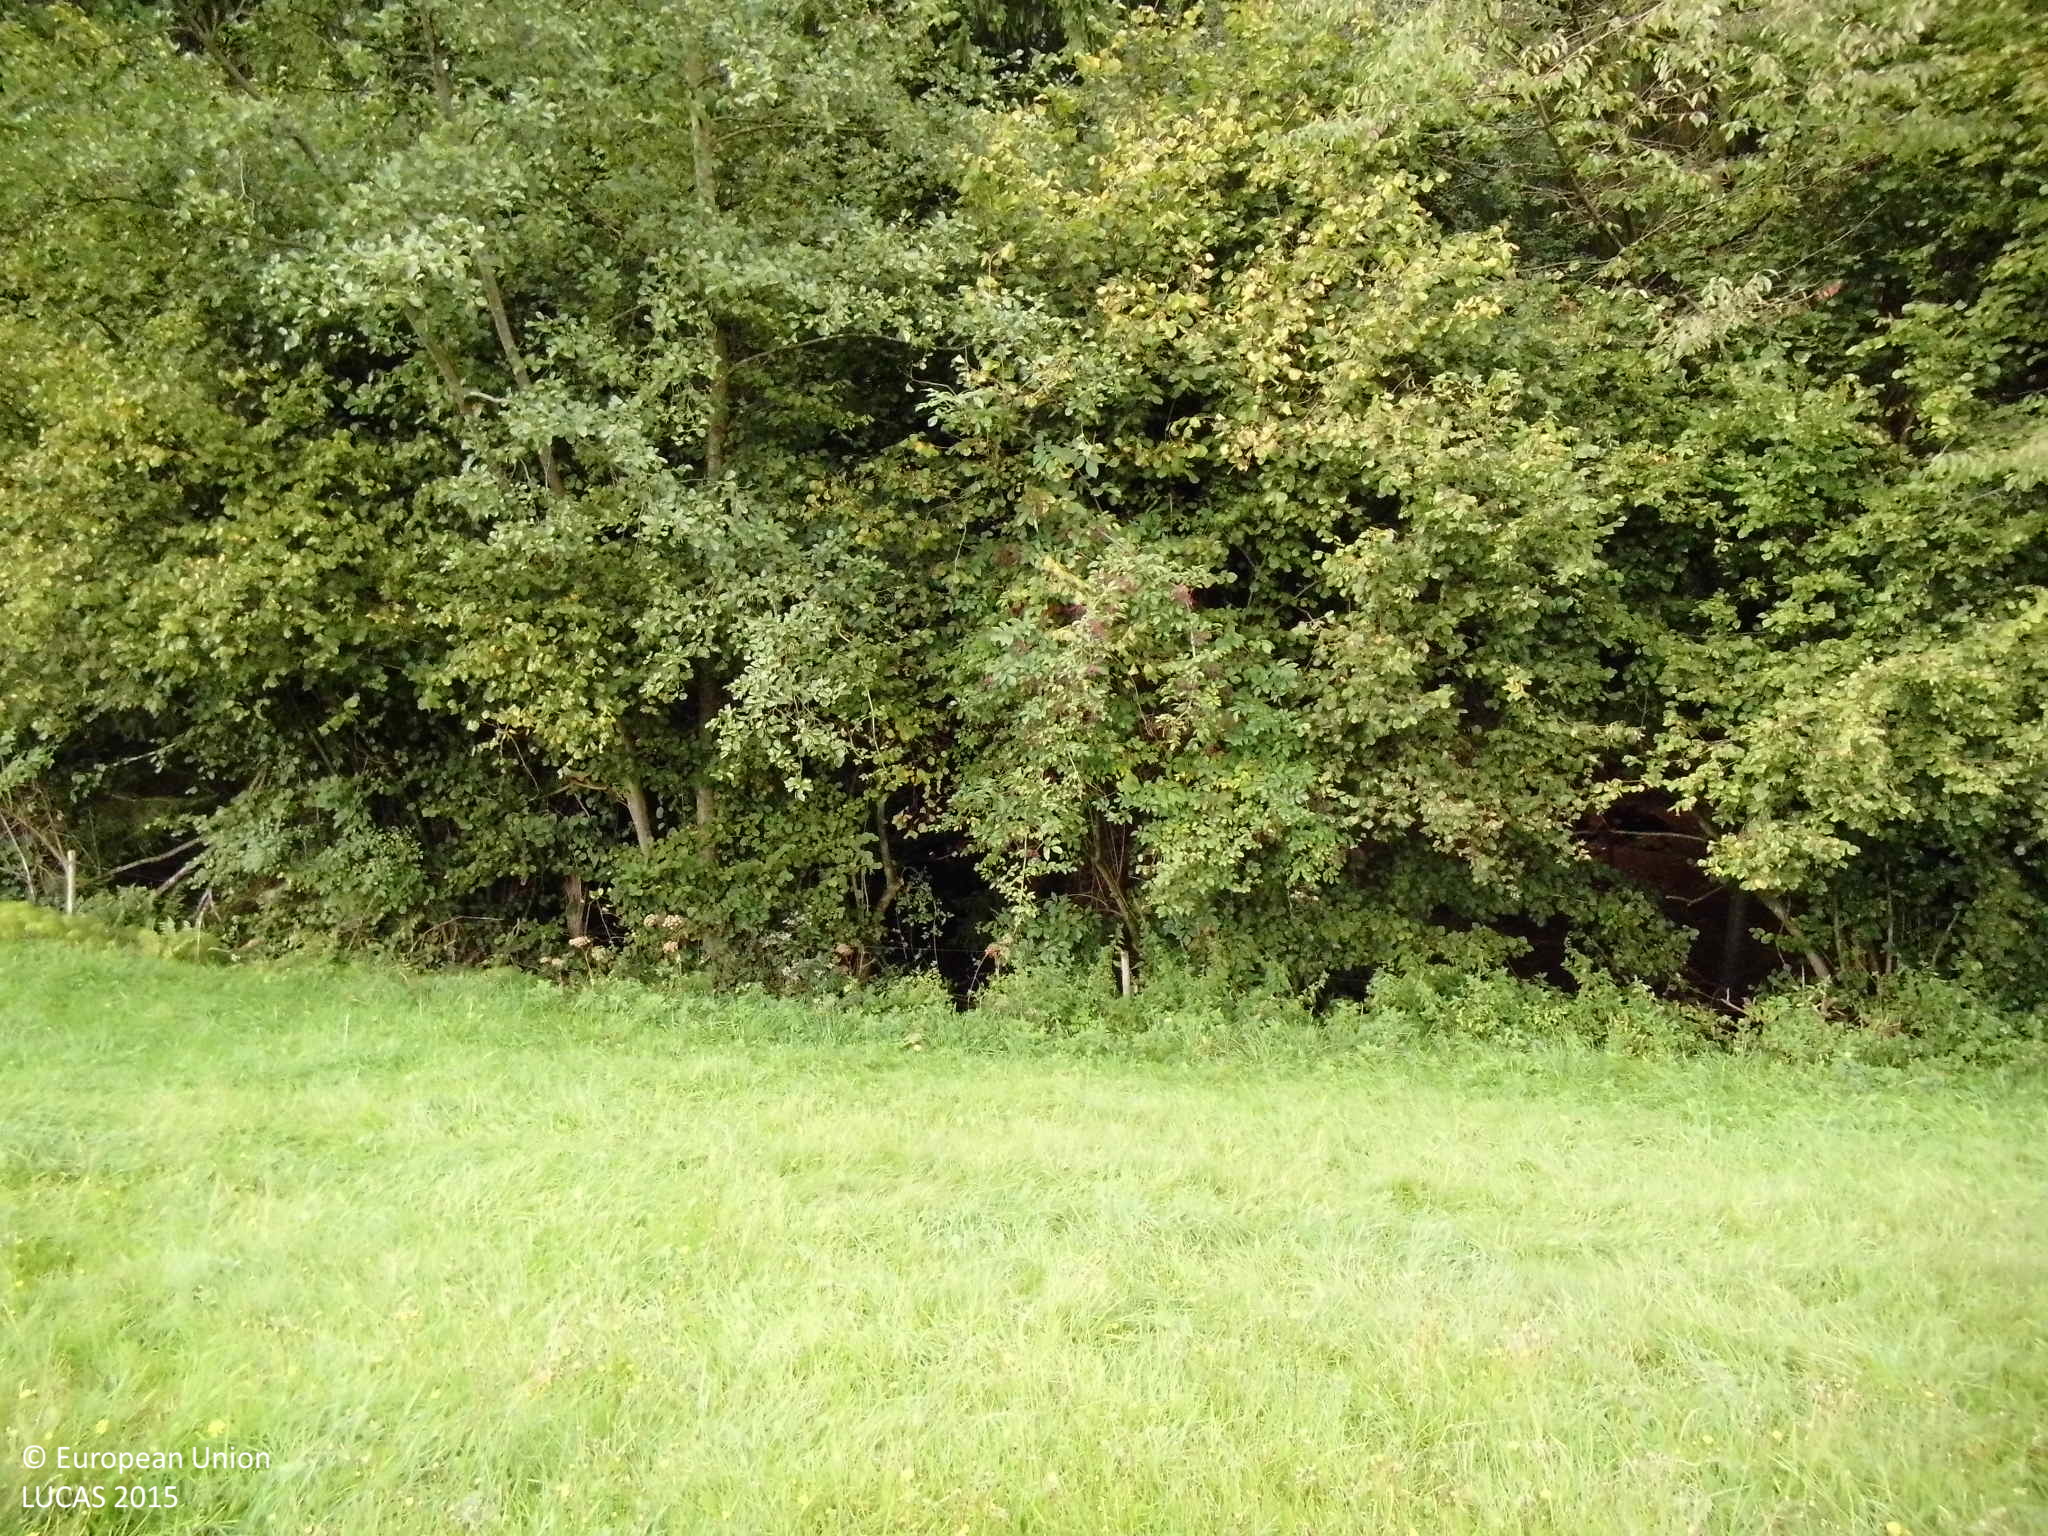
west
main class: Grassland
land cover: Grassland without tree/shrub cover
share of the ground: > 75 %
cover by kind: herbaceous plants 100 %
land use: Agriculture (excluding fallow land and kitchen gardens)
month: September
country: DE
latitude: 50.6592
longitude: 7.4398
